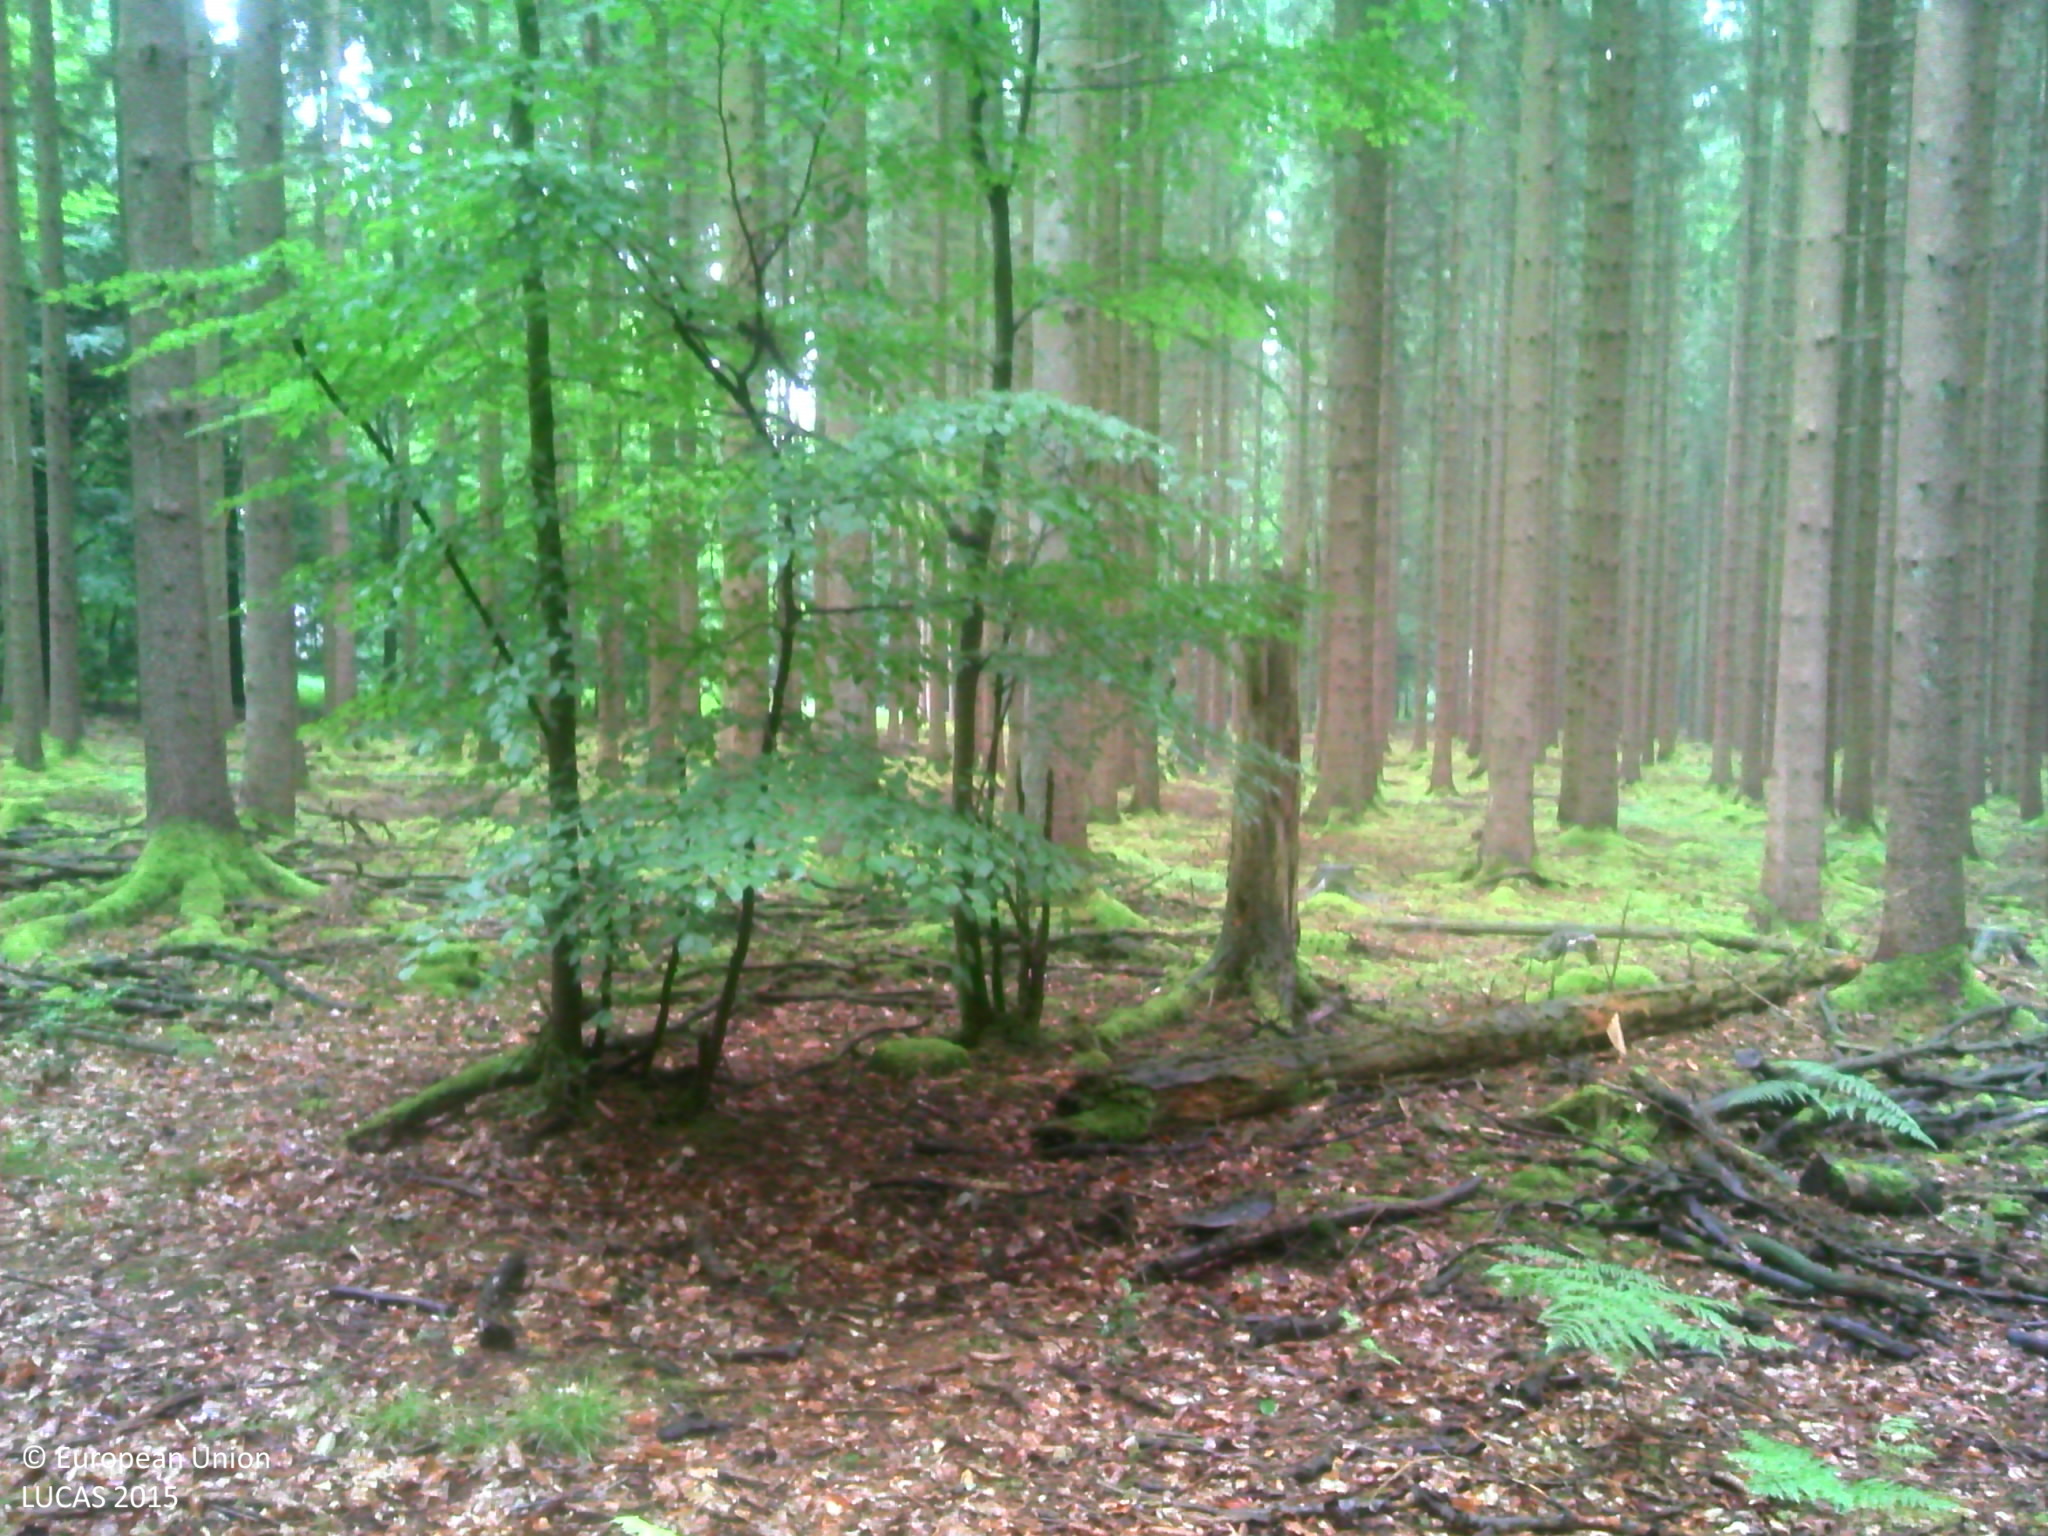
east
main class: Woodland
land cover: Broadleaved woodland
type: acidophilous oak and oak-birch forest
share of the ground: > 75 %
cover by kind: broadleaved forest trees 100 %
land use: Forestry
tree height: > 5 m
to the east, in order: Broadleaved woodland; Spruce dominated coniferous woodland; Broadleaved woodland; Tracks; Broadleaved woodland
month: July
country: BE
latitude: 50.0419
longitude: 4.6765
